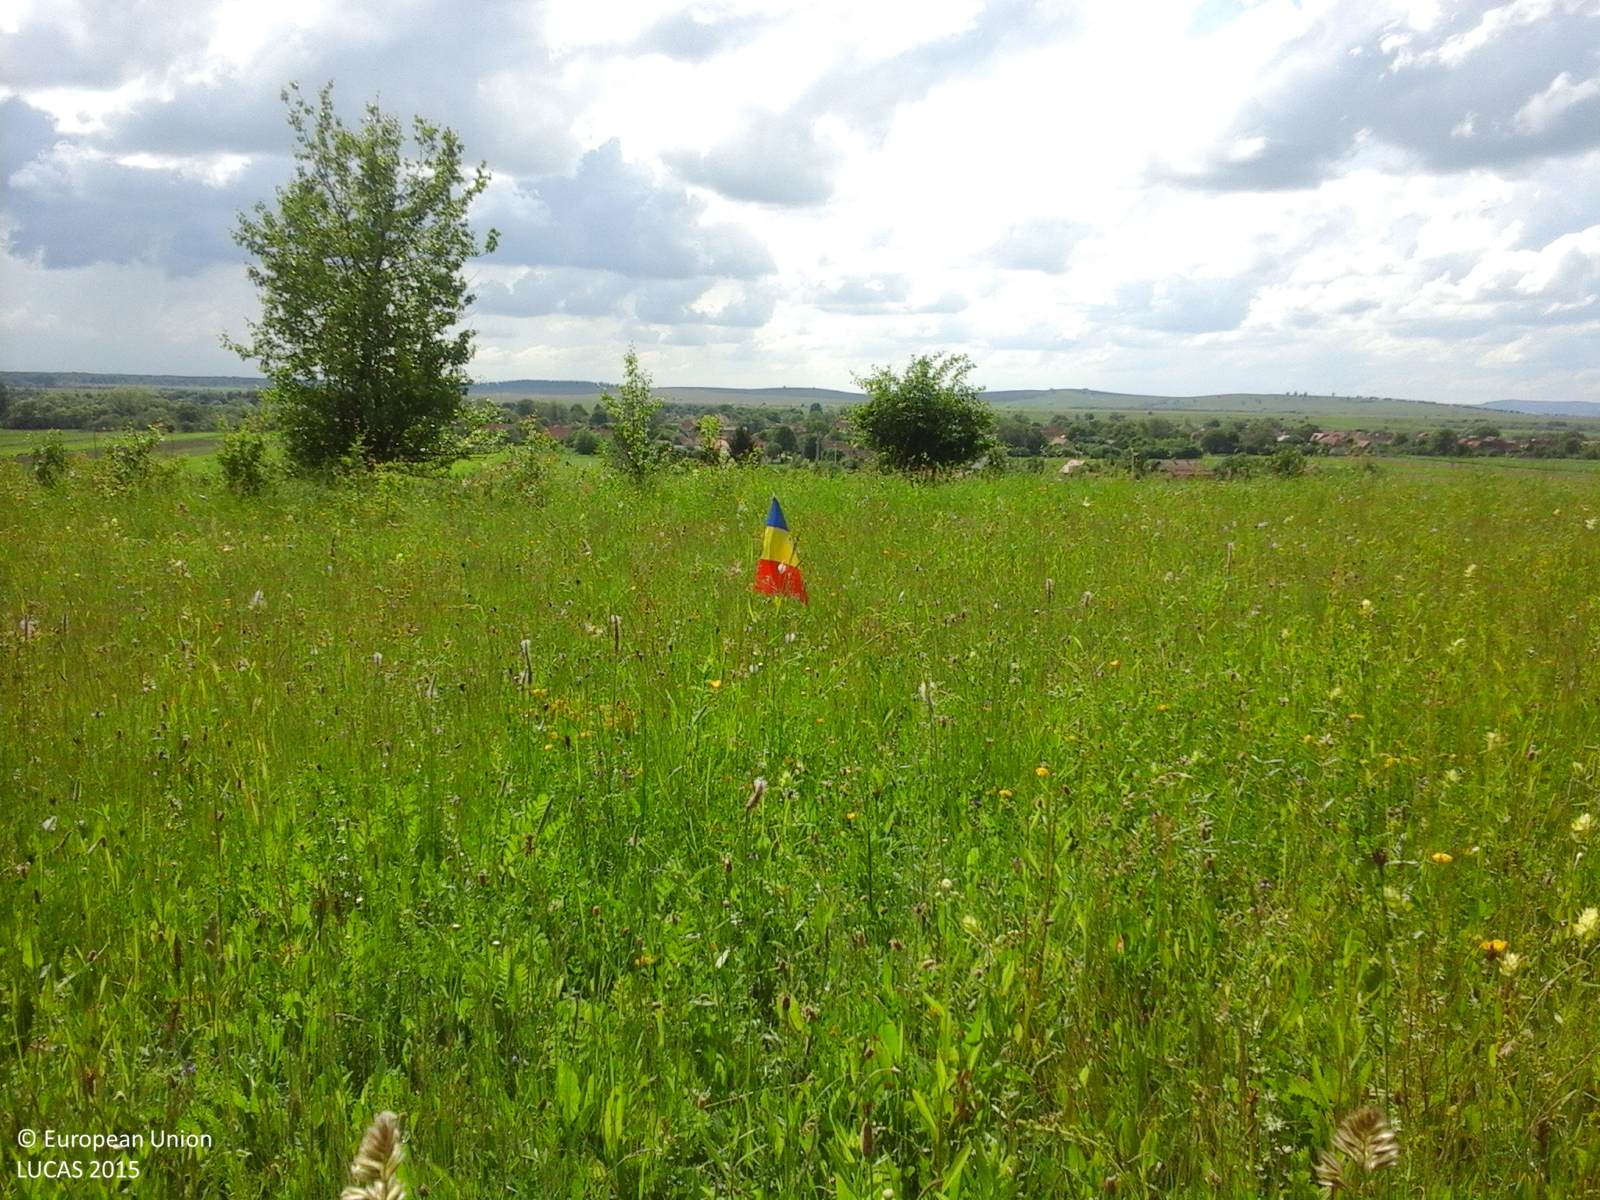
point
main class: Cropland
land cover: Other leguminous and mixtures for fodder
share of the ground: > 75 %
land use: Agriculture (excluding fallow land and kitchen gardens)
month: May
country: RO
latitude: 45.7939
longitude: 25.1603
